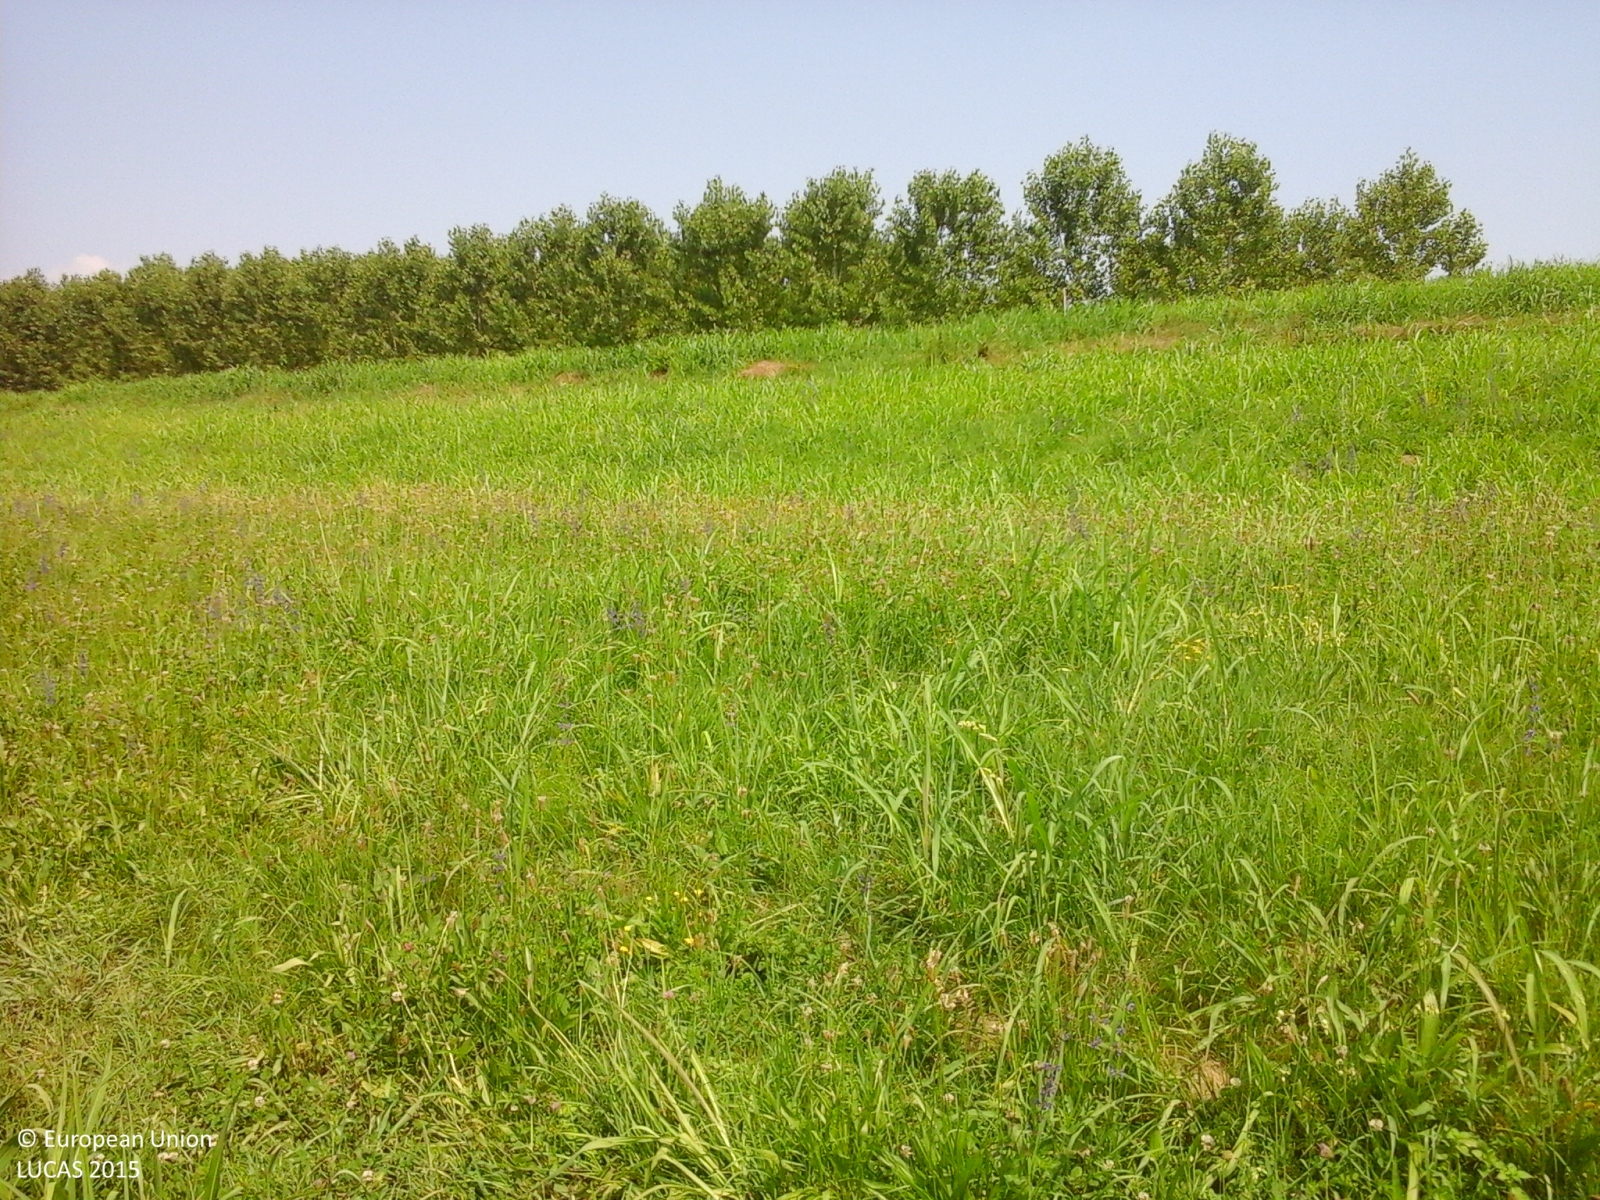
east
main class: Cropland
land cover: Maize
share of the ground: > 75 %
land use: Agriculture (excluding fallow land and kitchen gardens)
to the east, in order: Maize; Grassland without tree/shrub cover; Tracks; Grassland without tree/shrub cover; Broadleaved woodland
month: June
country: IT
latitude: 45.1068
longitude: 9.5306
